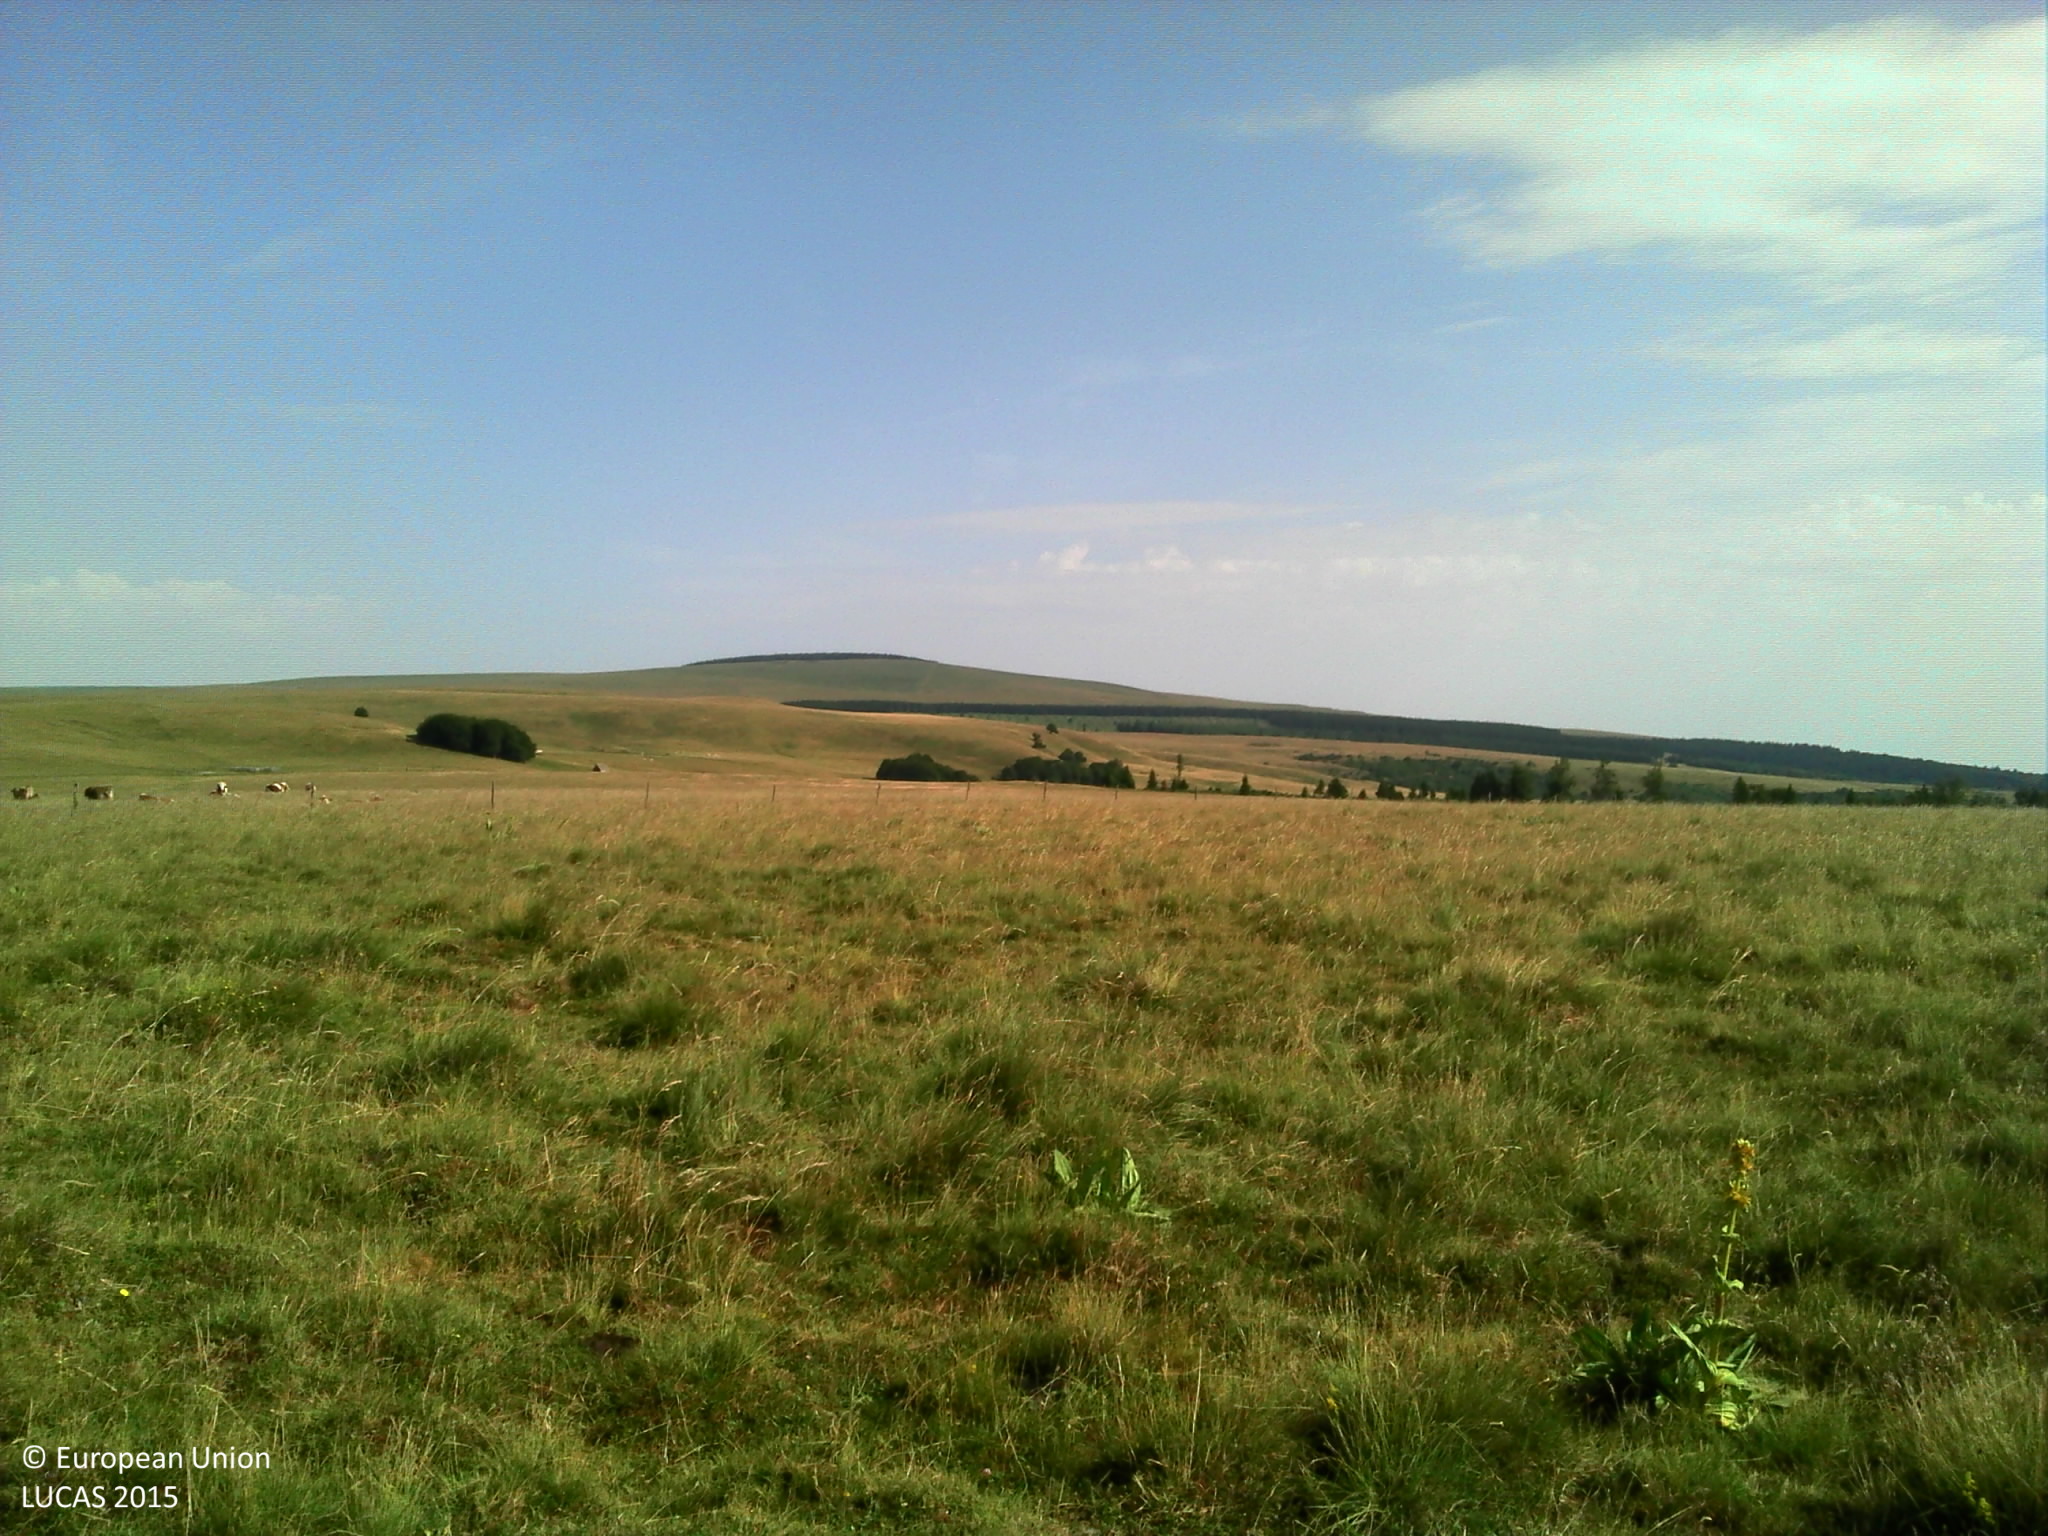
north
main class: Grassland
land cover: Grassland without tree/shrub cover
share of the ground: > 75 %
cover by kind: herbaceous plants 100 %
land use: Agriculture (excluding fallow land and kitchen gardens)
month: July
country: FR
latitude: 45.2901
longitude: 3.0011
